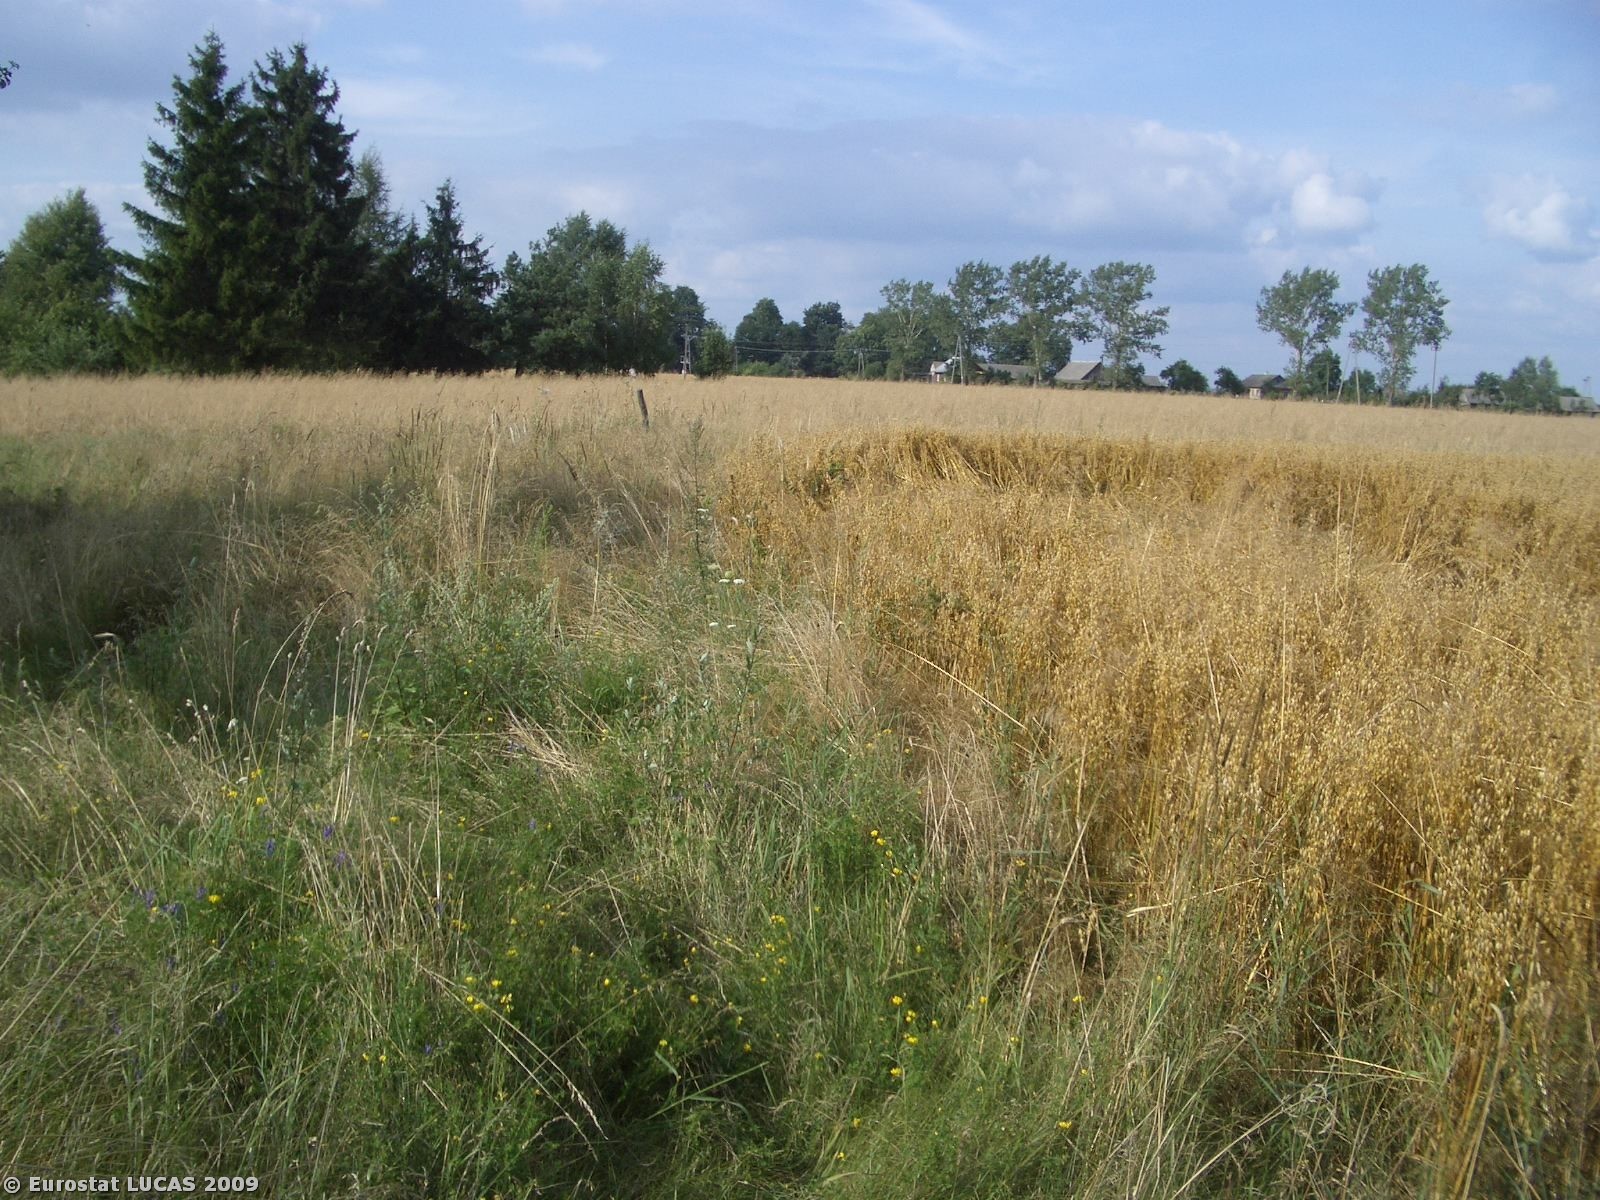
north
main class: Grassland
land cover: Grassland with sparse tree/shrub cover
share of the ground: > 75 %
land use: Unused
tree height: > 5 m
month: August
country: PL
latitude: 51.6412
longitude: 23.1555
